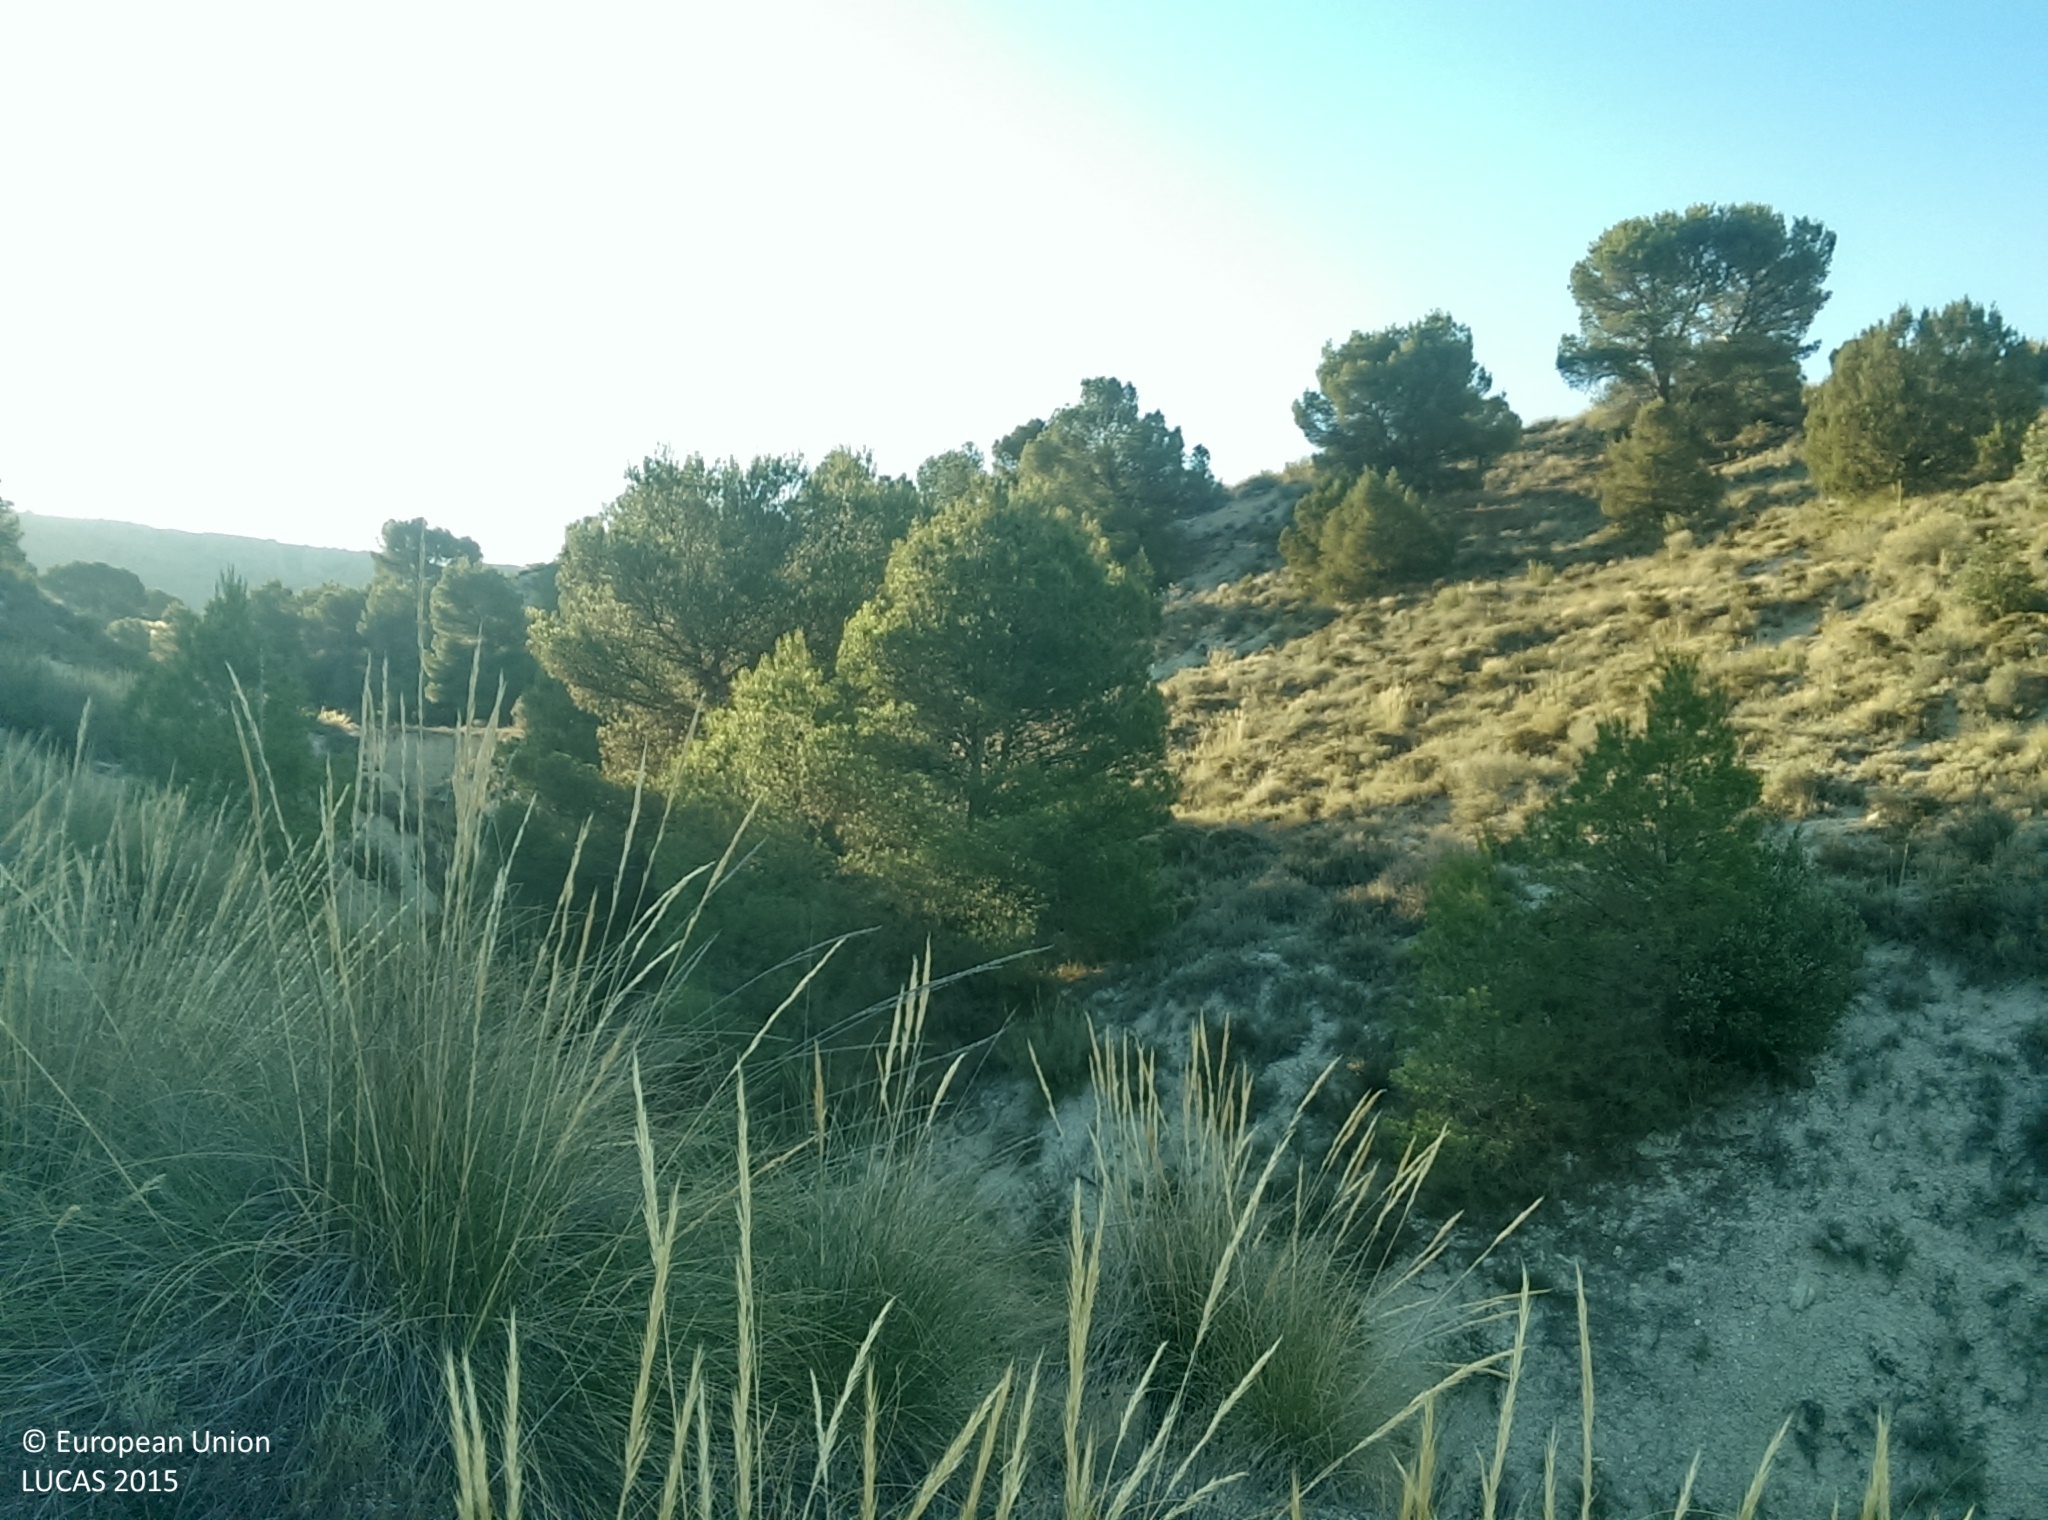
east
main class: Shrubland
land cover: Shrubland without tree cover
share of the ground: 25 - 50 %
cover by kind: herbaceous plants 60 %, shrubs 30 %, unconsolidated bare surface 10 %
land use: Forestry
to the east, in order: Rivers and streams; Shrubland without tree cover; Pine dominated coniferous woodland; Shrubland with sparse tree cover; Rivers and streams; Shrubland with sparse tree cover; Shrubland without tree cover
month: June
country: ES
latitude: 37.5954
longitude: -3.1868
